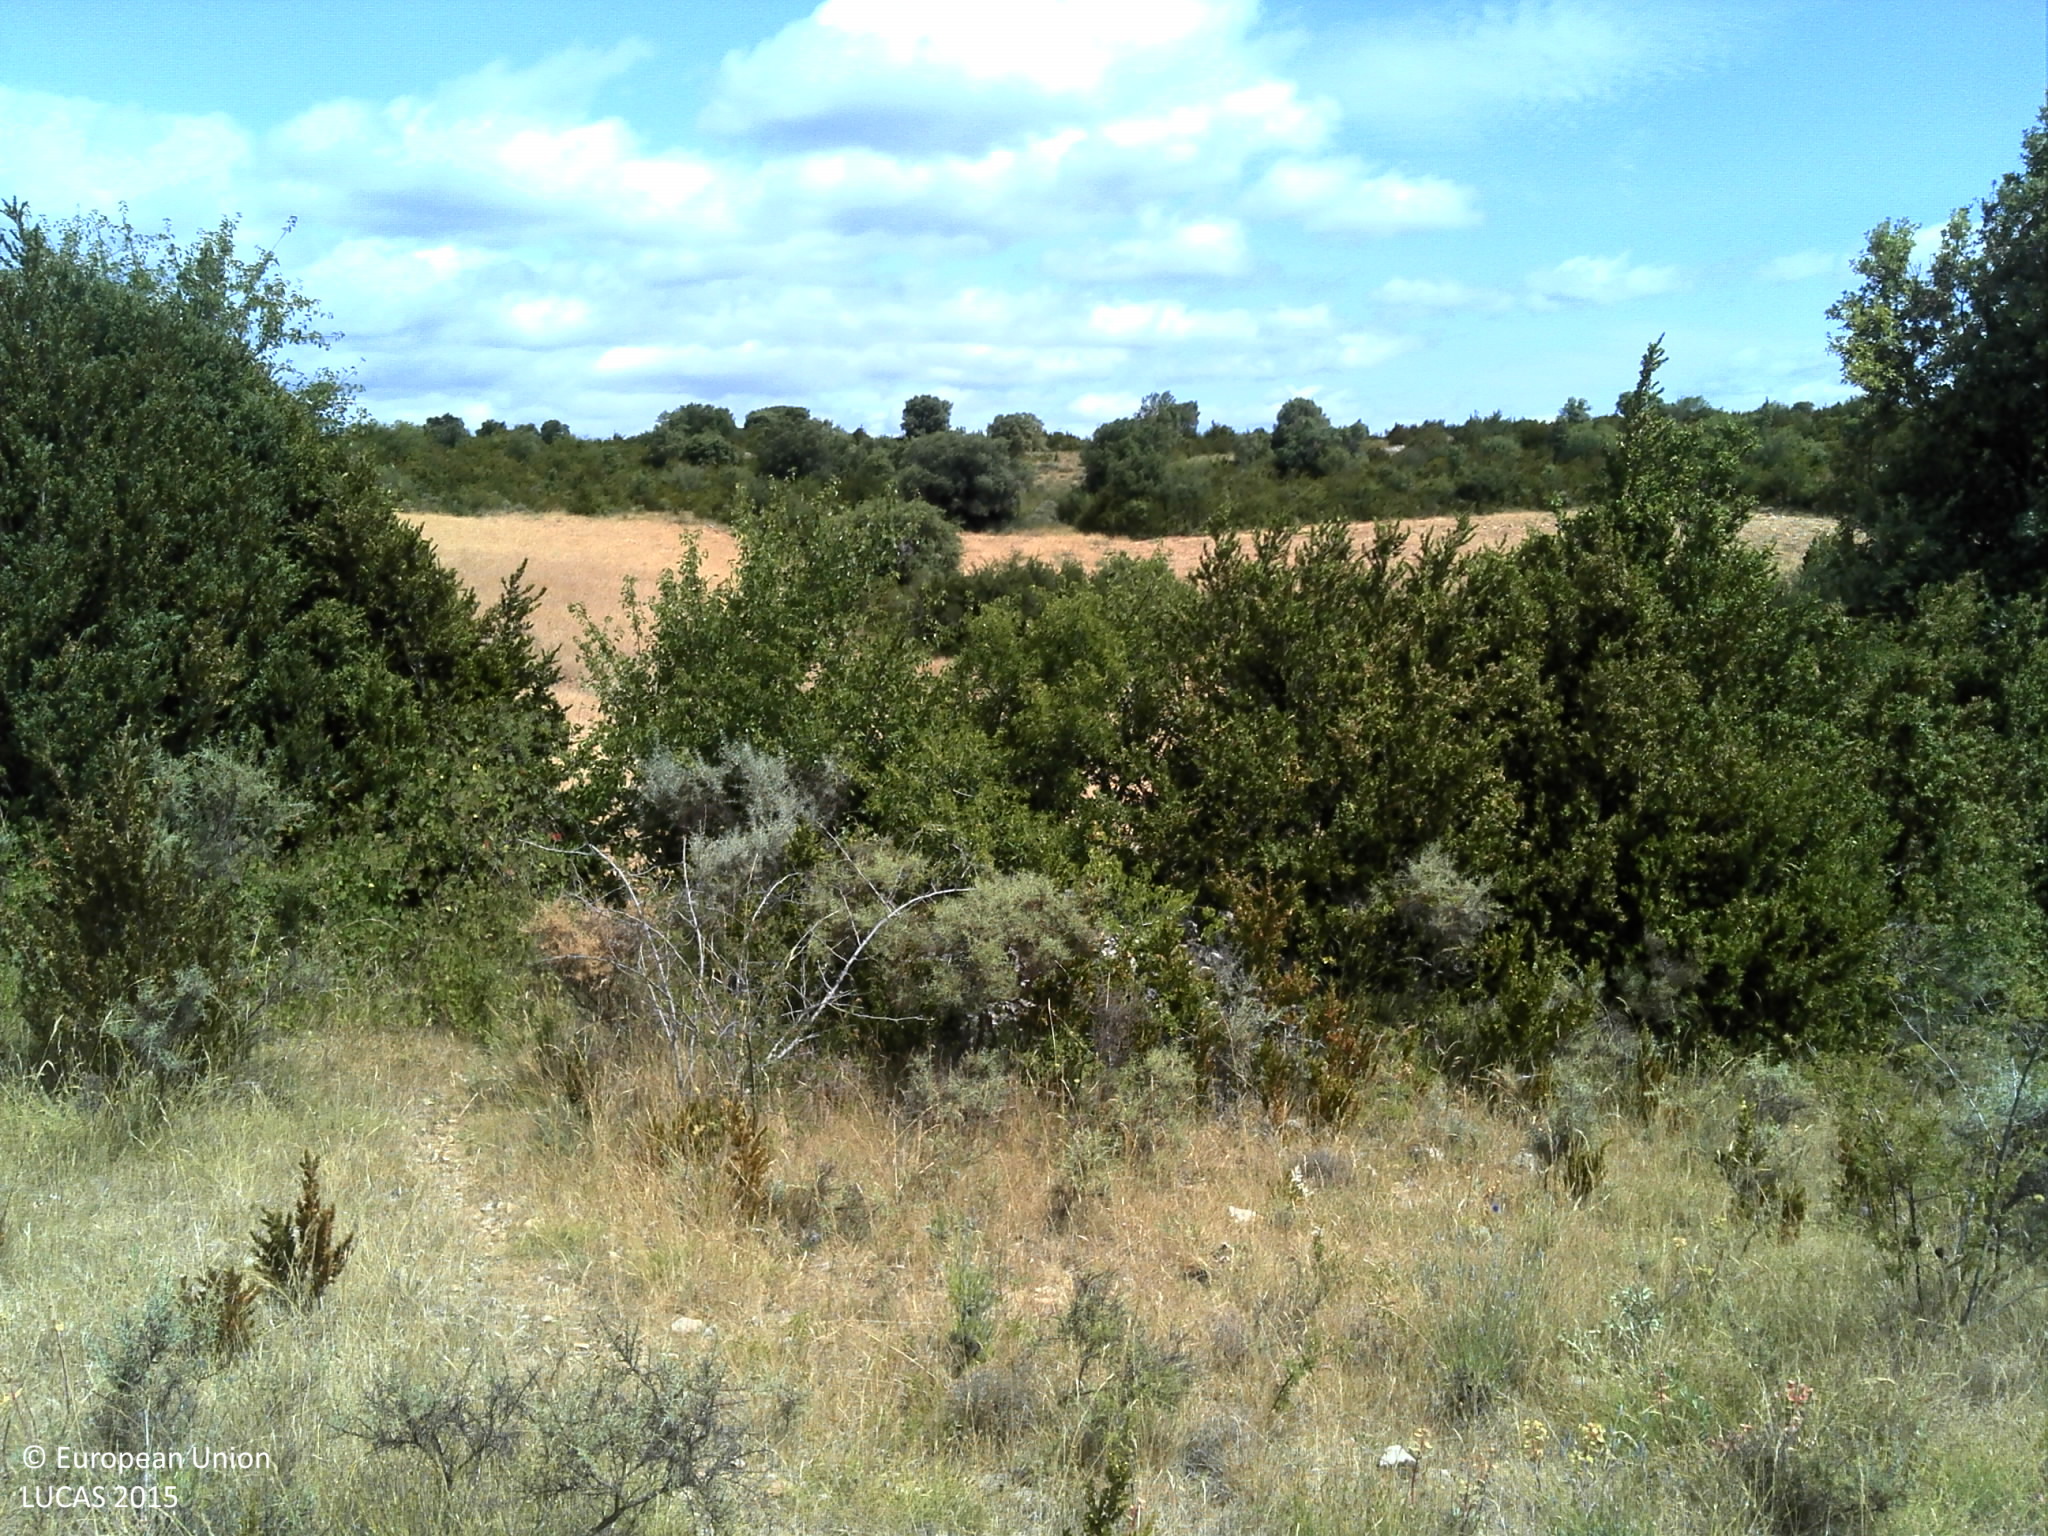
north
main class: Shrubland
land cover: Shrubland without tree cover
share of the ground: > 75 %
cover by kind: herbaceous plants 60 %, shrubs 20 %, consolidated bare surface 15 %, unconsolidated bare surface 5 %
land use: Semi-natural and natural areas not in use
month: July
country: FR
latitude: 43.6748
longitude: 3.1985
